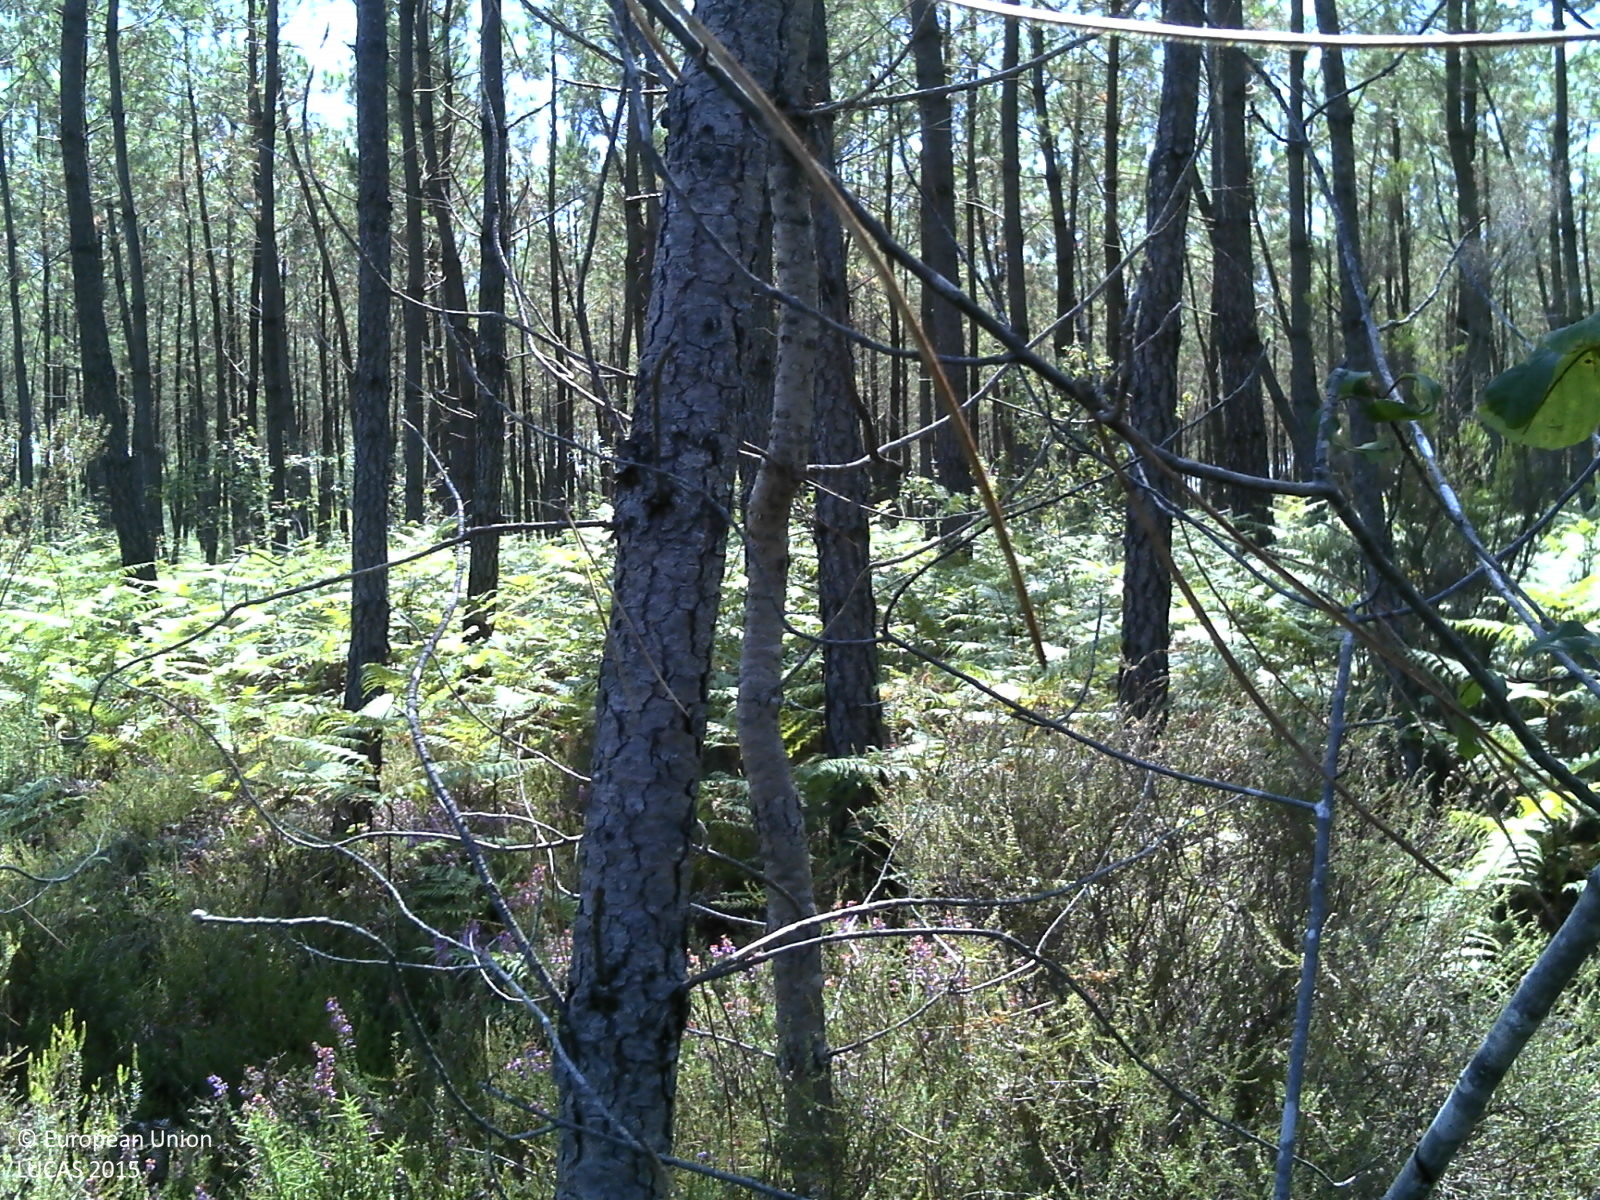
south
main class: Woodland
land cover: Pine dominated coniferous woodland
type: exotic forest
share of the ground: > 75 %
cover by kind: coniferous forest trees 60 %, shrubs 30 %, herbaceous plants 5 %, lichens and mosses 5 %
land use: Forestry
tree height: > 5 m
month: August
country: FR
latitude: 44.4822
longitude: -0.5651
